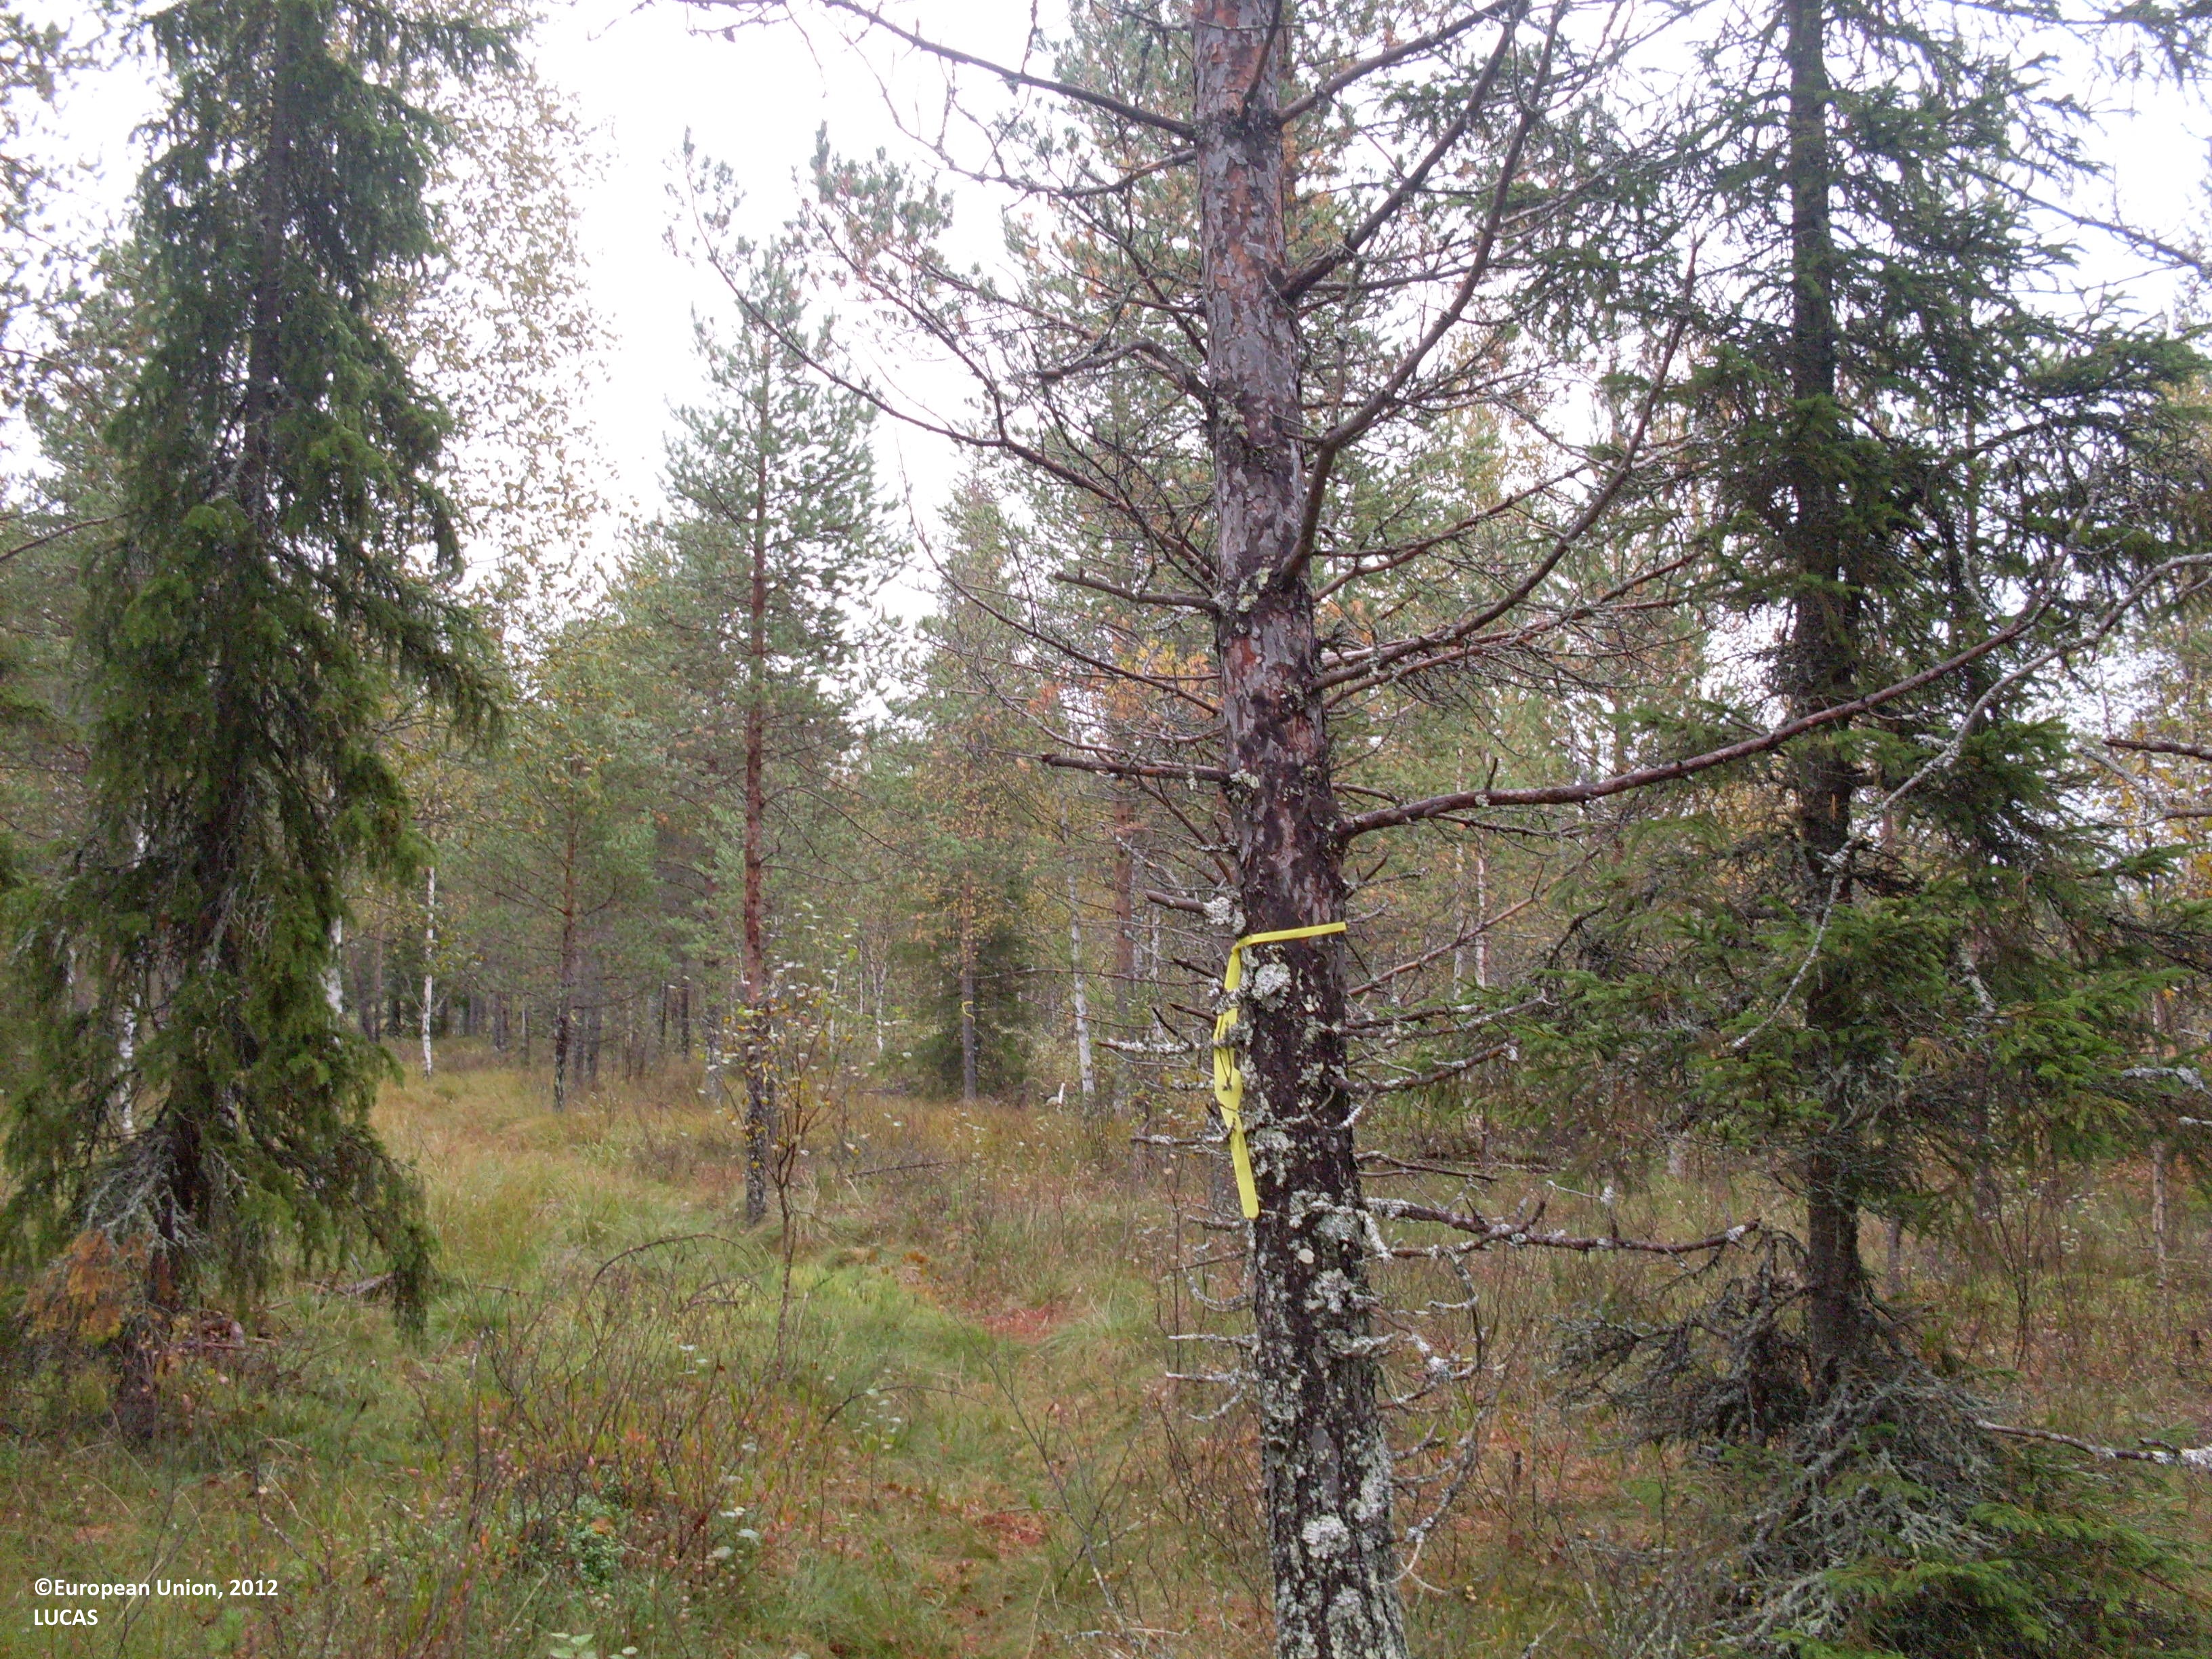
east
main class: Woodland
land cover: Other coniferous woodland
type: boreal forest
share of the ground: 50 - 75 %
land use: Forestry
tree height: > 5 m
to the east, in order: Other coniferous woodland; Ditches and canals; Other coniferous woodland; Peatbogs; Ditches and canals; Other coniferous woodland; Ditches and canals; Other coniferous woodland; Ditches and canals; Other coniferous woodland; Ditches and canals; Other coniferous woodland
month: September
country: FI
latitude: 64.0836
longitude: 30.2448
